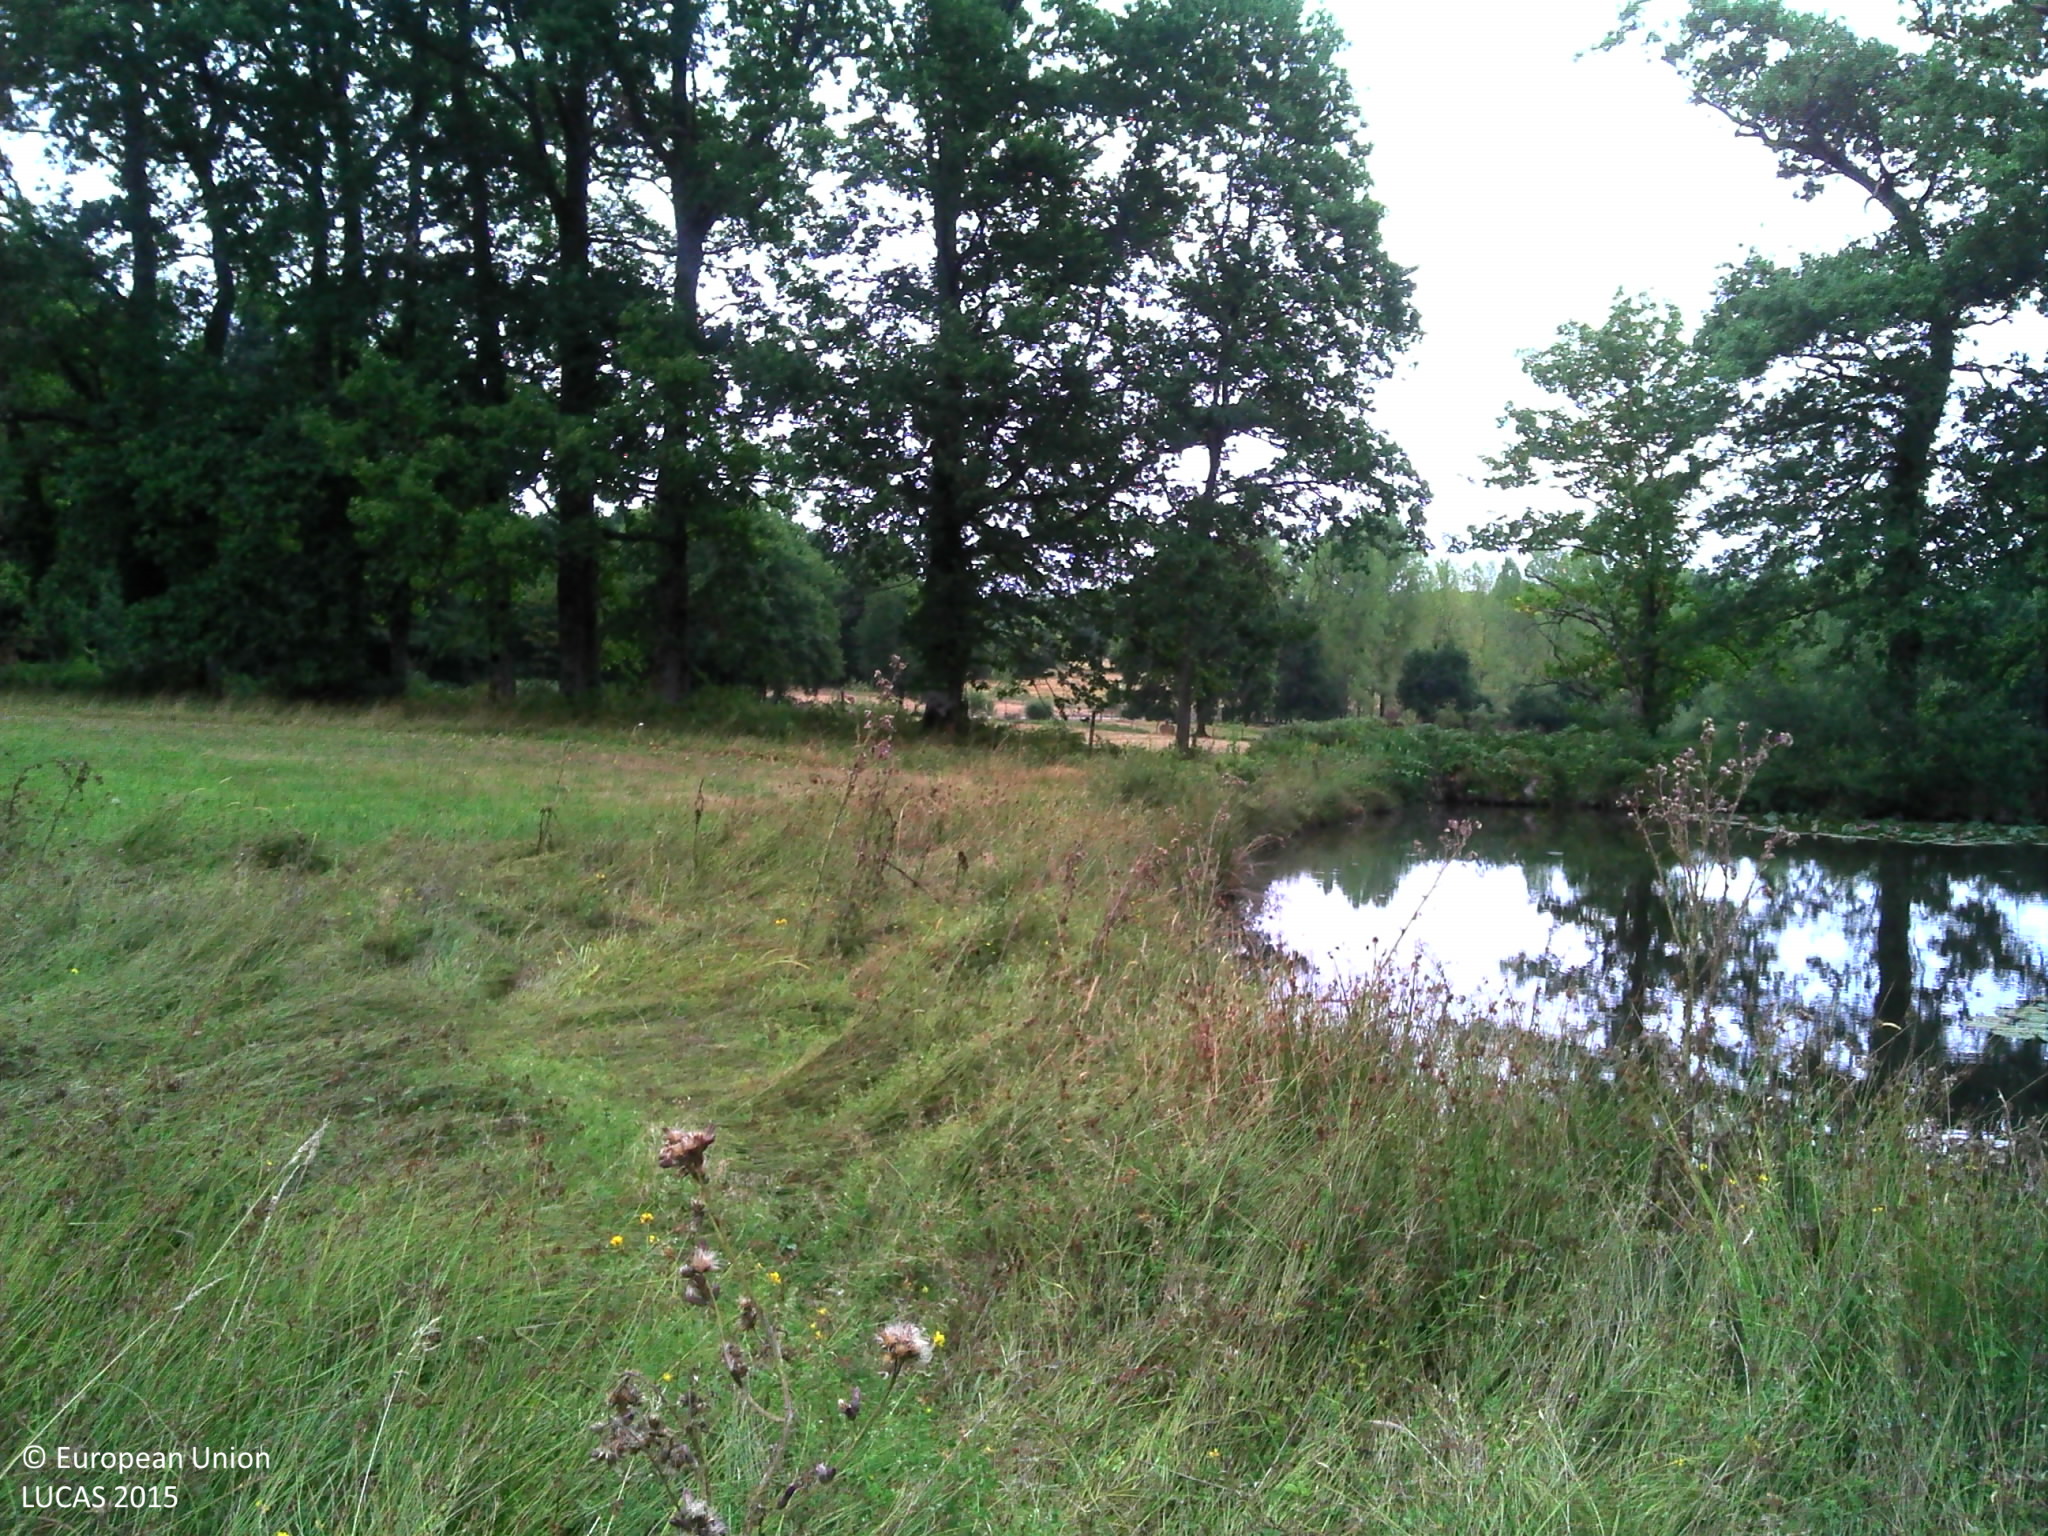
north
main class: Grassland
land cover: Grassland without tree/shrub cover
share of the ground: > 75 %
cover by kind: herbaceous plants 100 %
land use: Agriculture (excluding fallow land and kitchen gardens)
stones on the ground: < 10 %
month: July
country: FR
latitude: 45.5645
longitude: 0.6993
